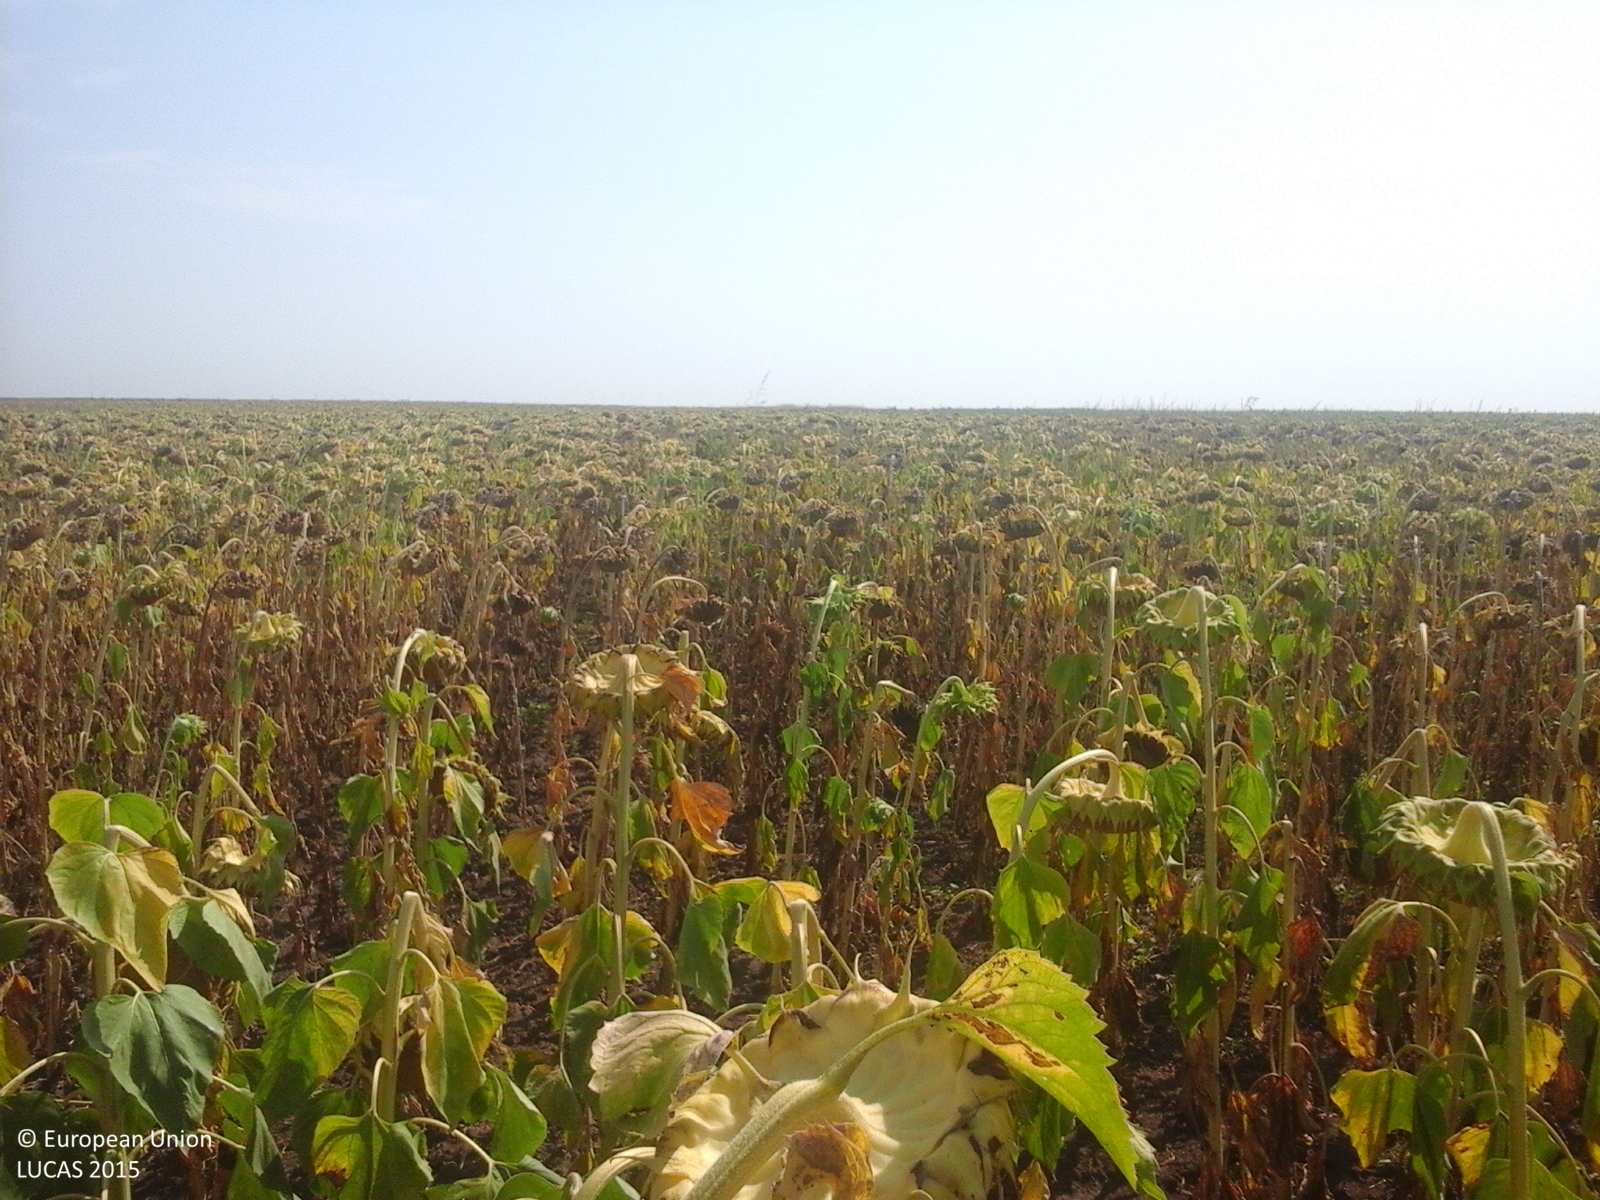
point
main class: Cropland
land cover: Sunflower
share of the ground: > 75 %
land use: Agriculture (excluding fallow land and kitchen gardens)
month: August
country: RO
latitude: 45.7251
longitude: 27.5946
